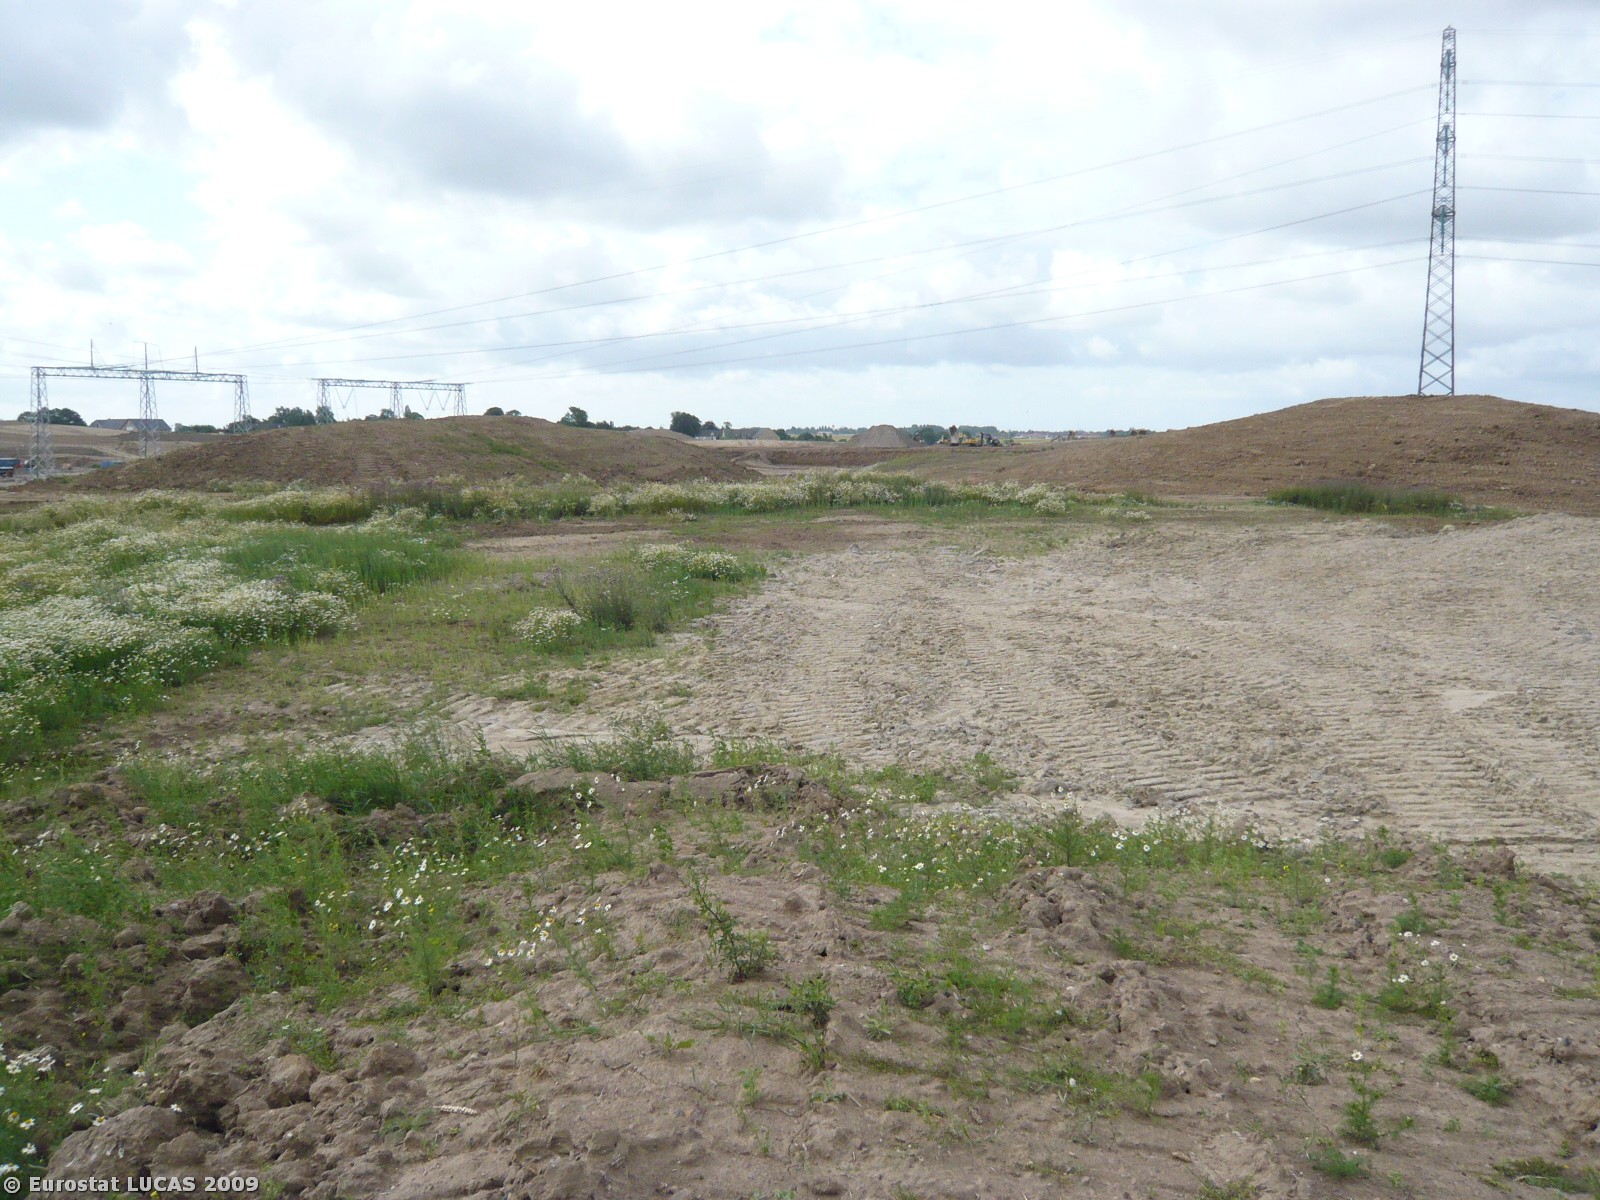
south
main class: Grassland
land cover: Spontaneously vegetated surfaces
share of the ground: > 75 %
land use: Fallow land
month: July
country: DK
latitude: 55.5338
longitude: 11.3139
